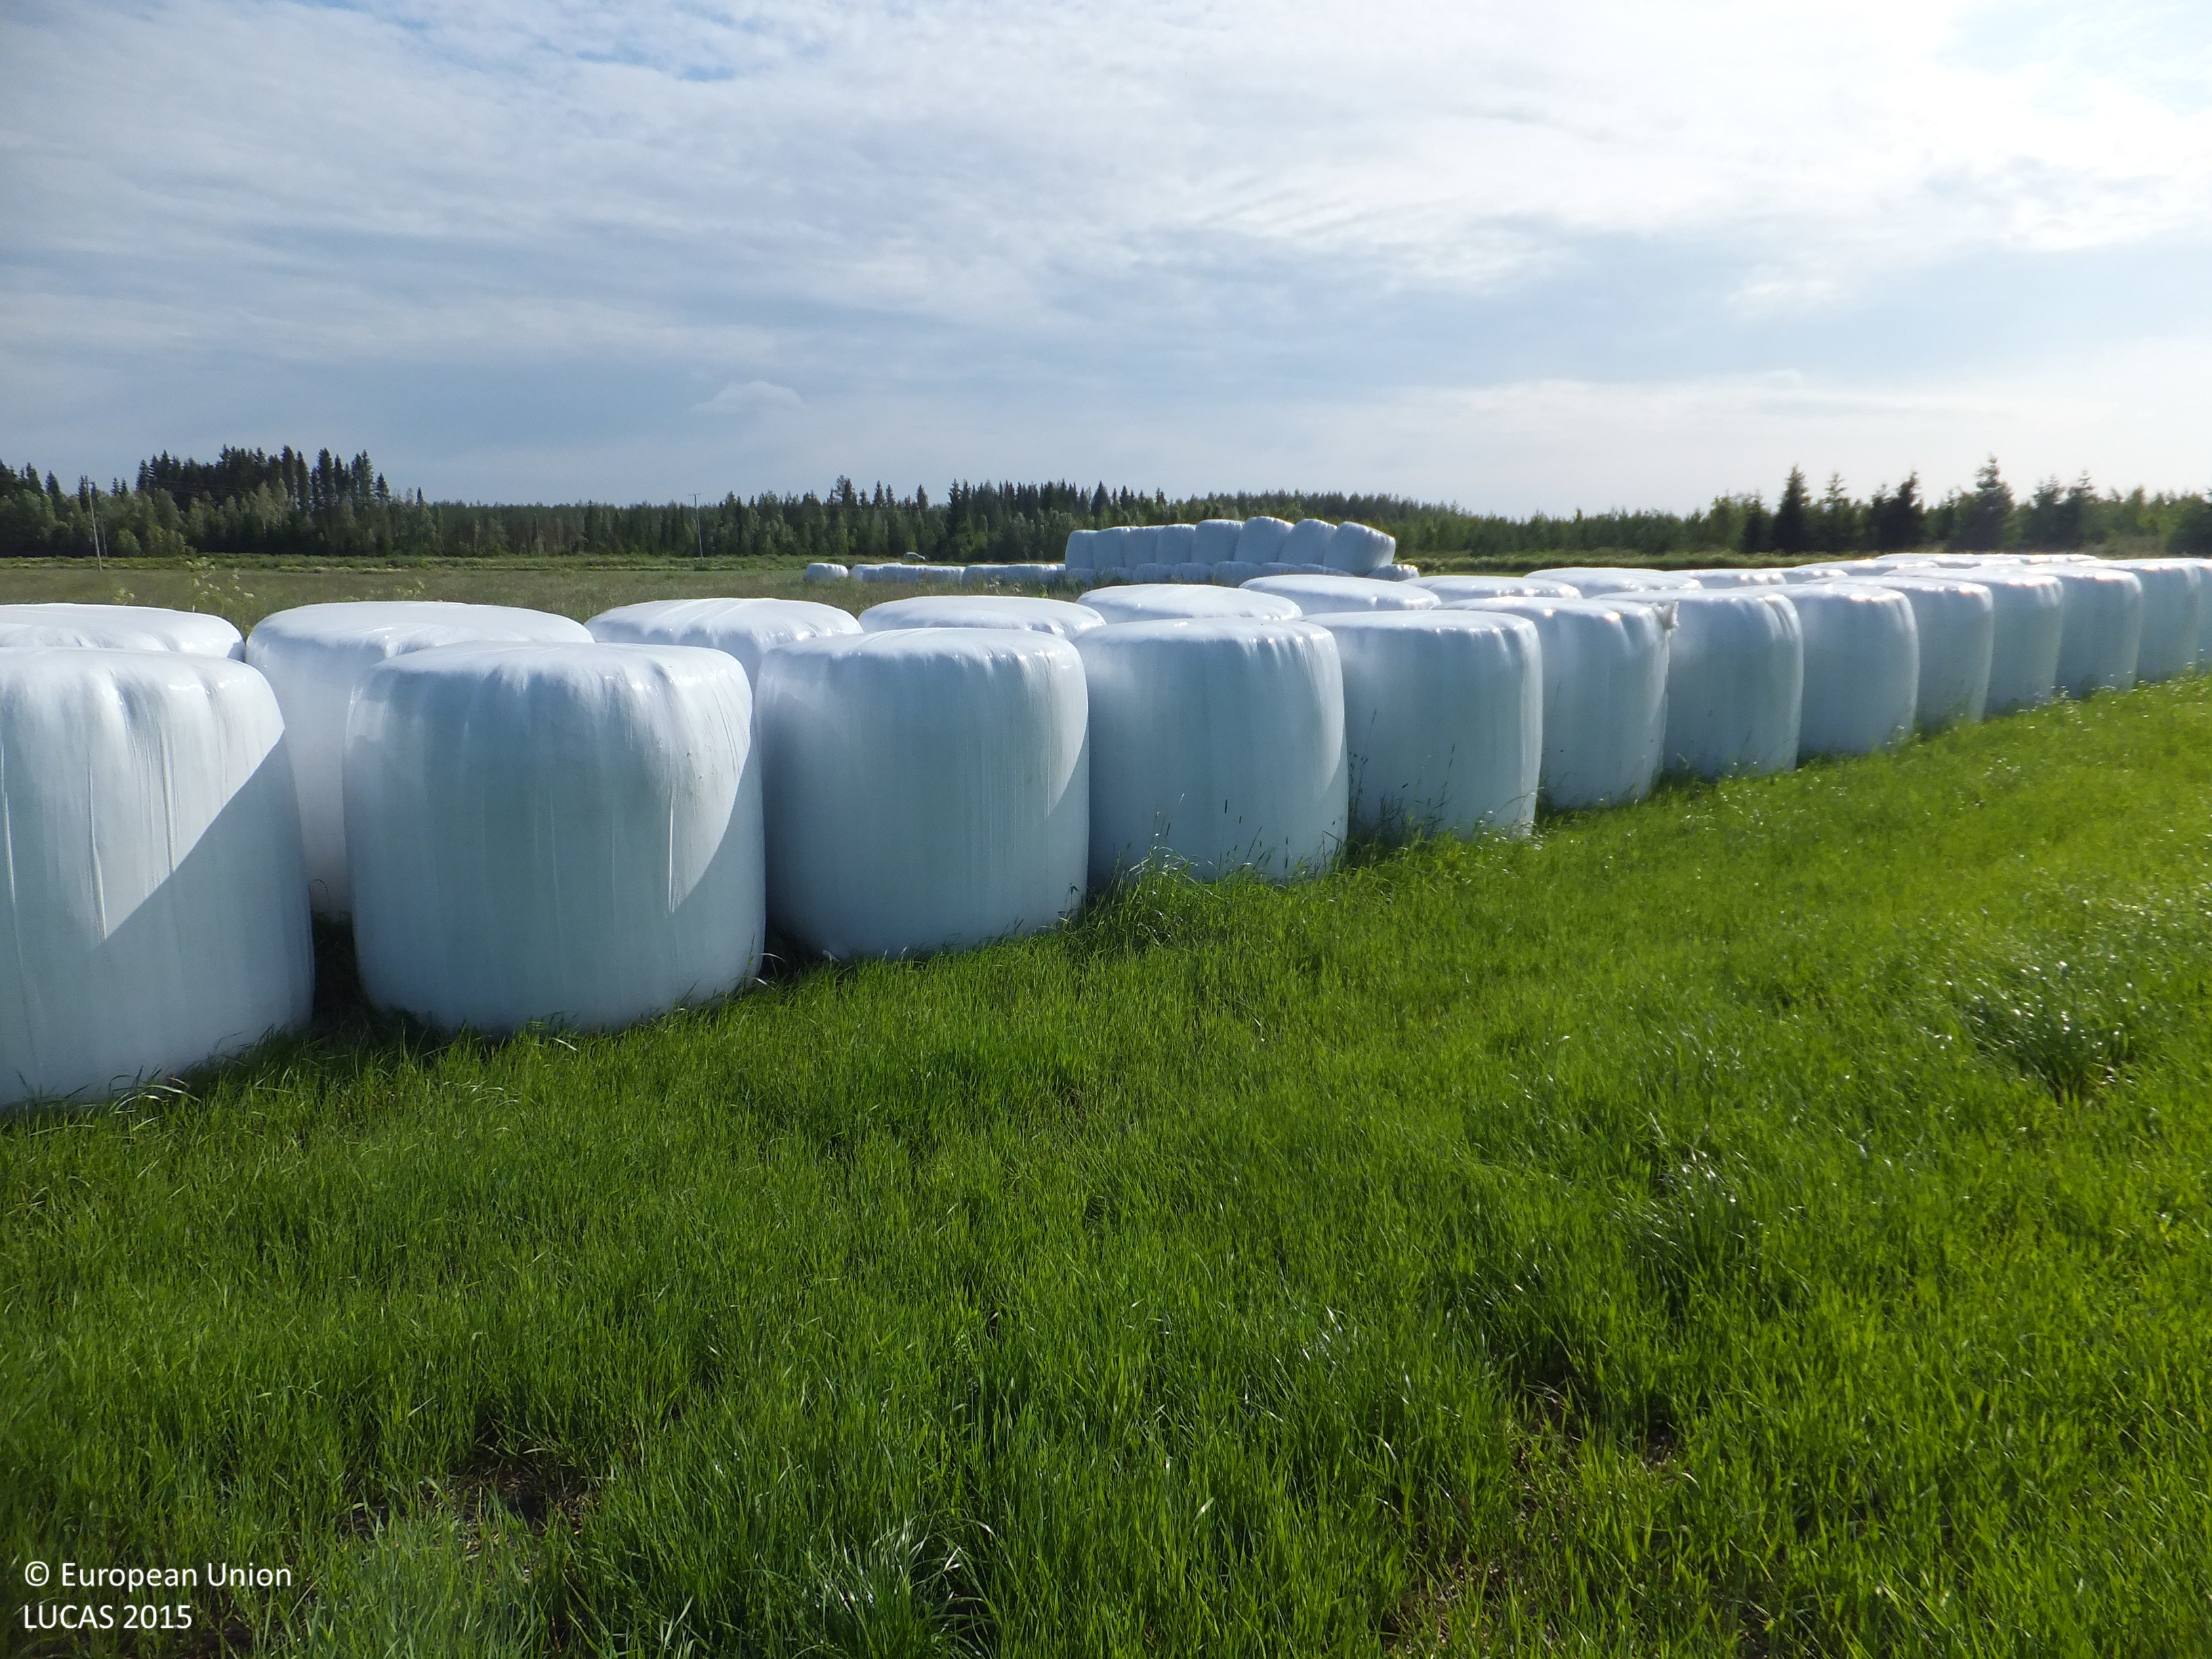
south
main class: Cropland
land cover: Temporary grasslands
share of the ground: > 75 %
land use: Agriculture (excluding fallow land and kitchen gardens)
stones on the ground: < 10 %
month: July
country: FI
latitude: 63.6345
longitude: 23.0719
